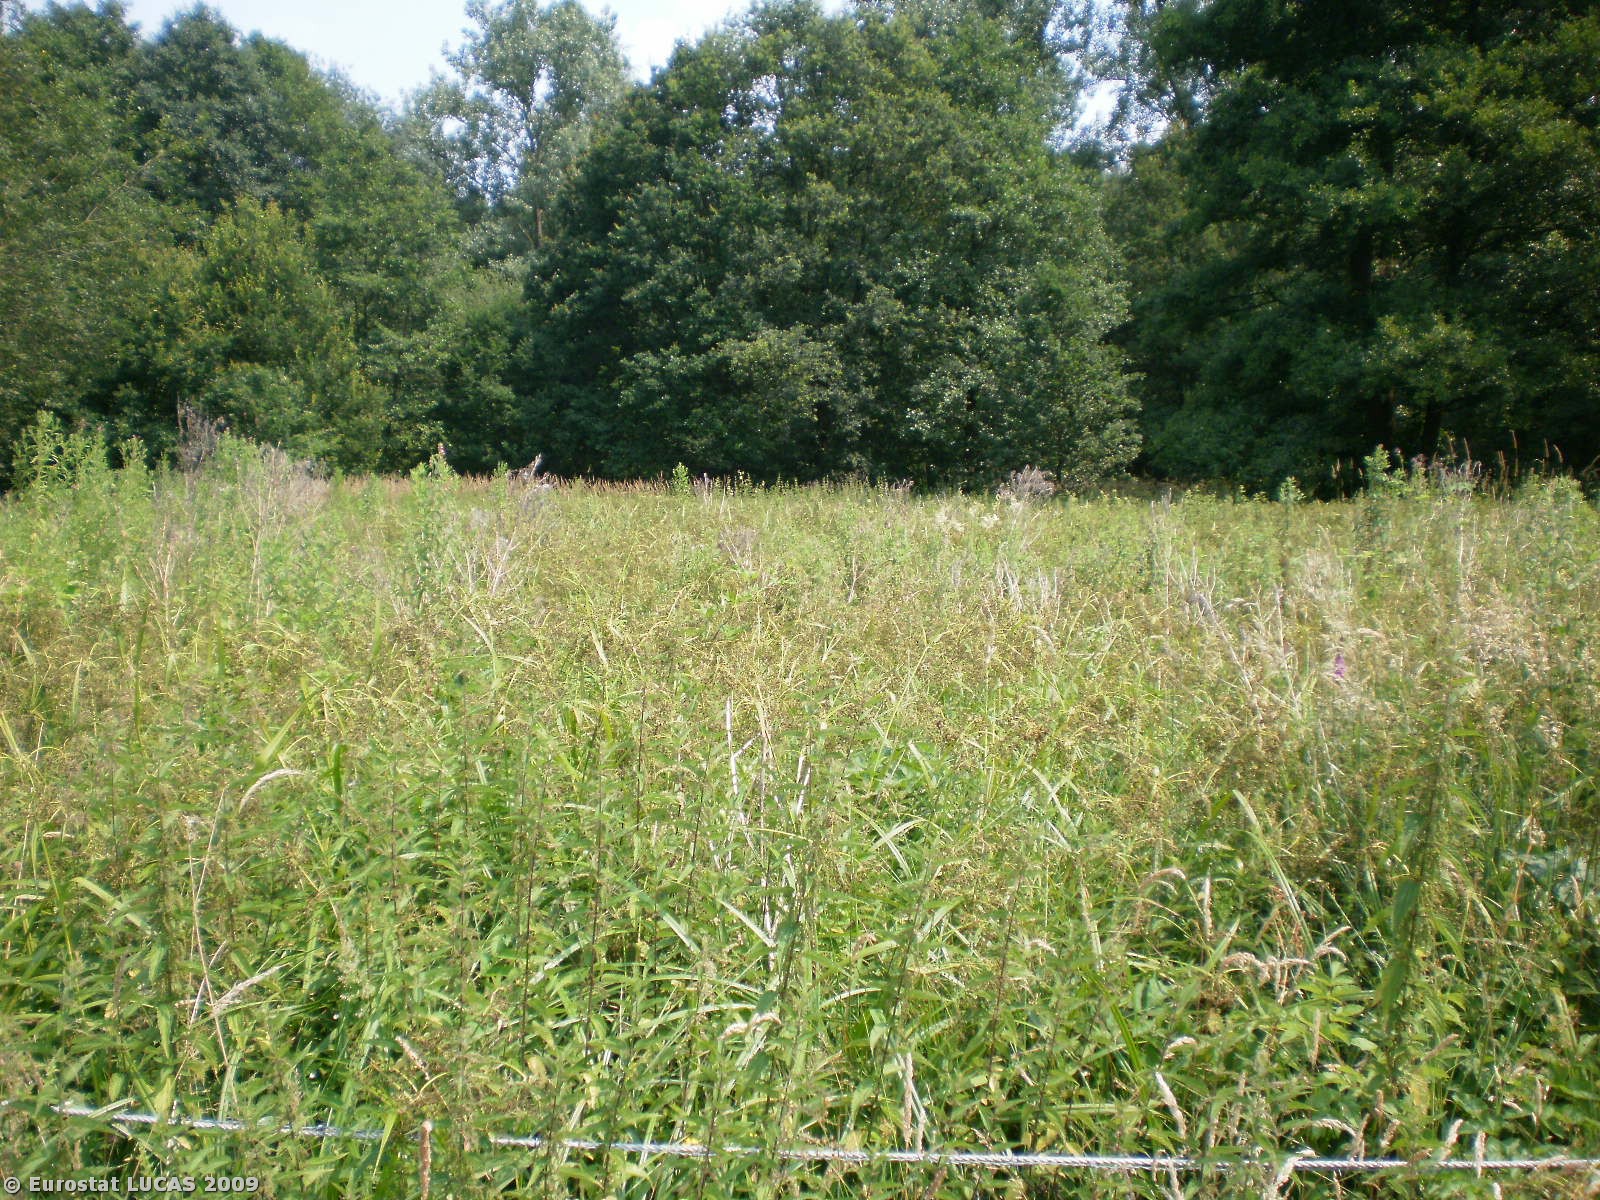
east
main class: Woodland
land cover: Broadleaved woodland
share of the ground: > 75 %
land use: Amenities, museums, leisure
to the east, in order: Broadleaved woodland; Ditches and canals; Broadleaved woodland; Inland water bodies; Groves; Grassland without tree/shrub cover; Inland water bodies; Groves; Grassland without tree/shrub cover; Broadleaved woodland; Mixed woodland
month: July
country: BE
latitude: 51.1409
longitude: 5.5244
